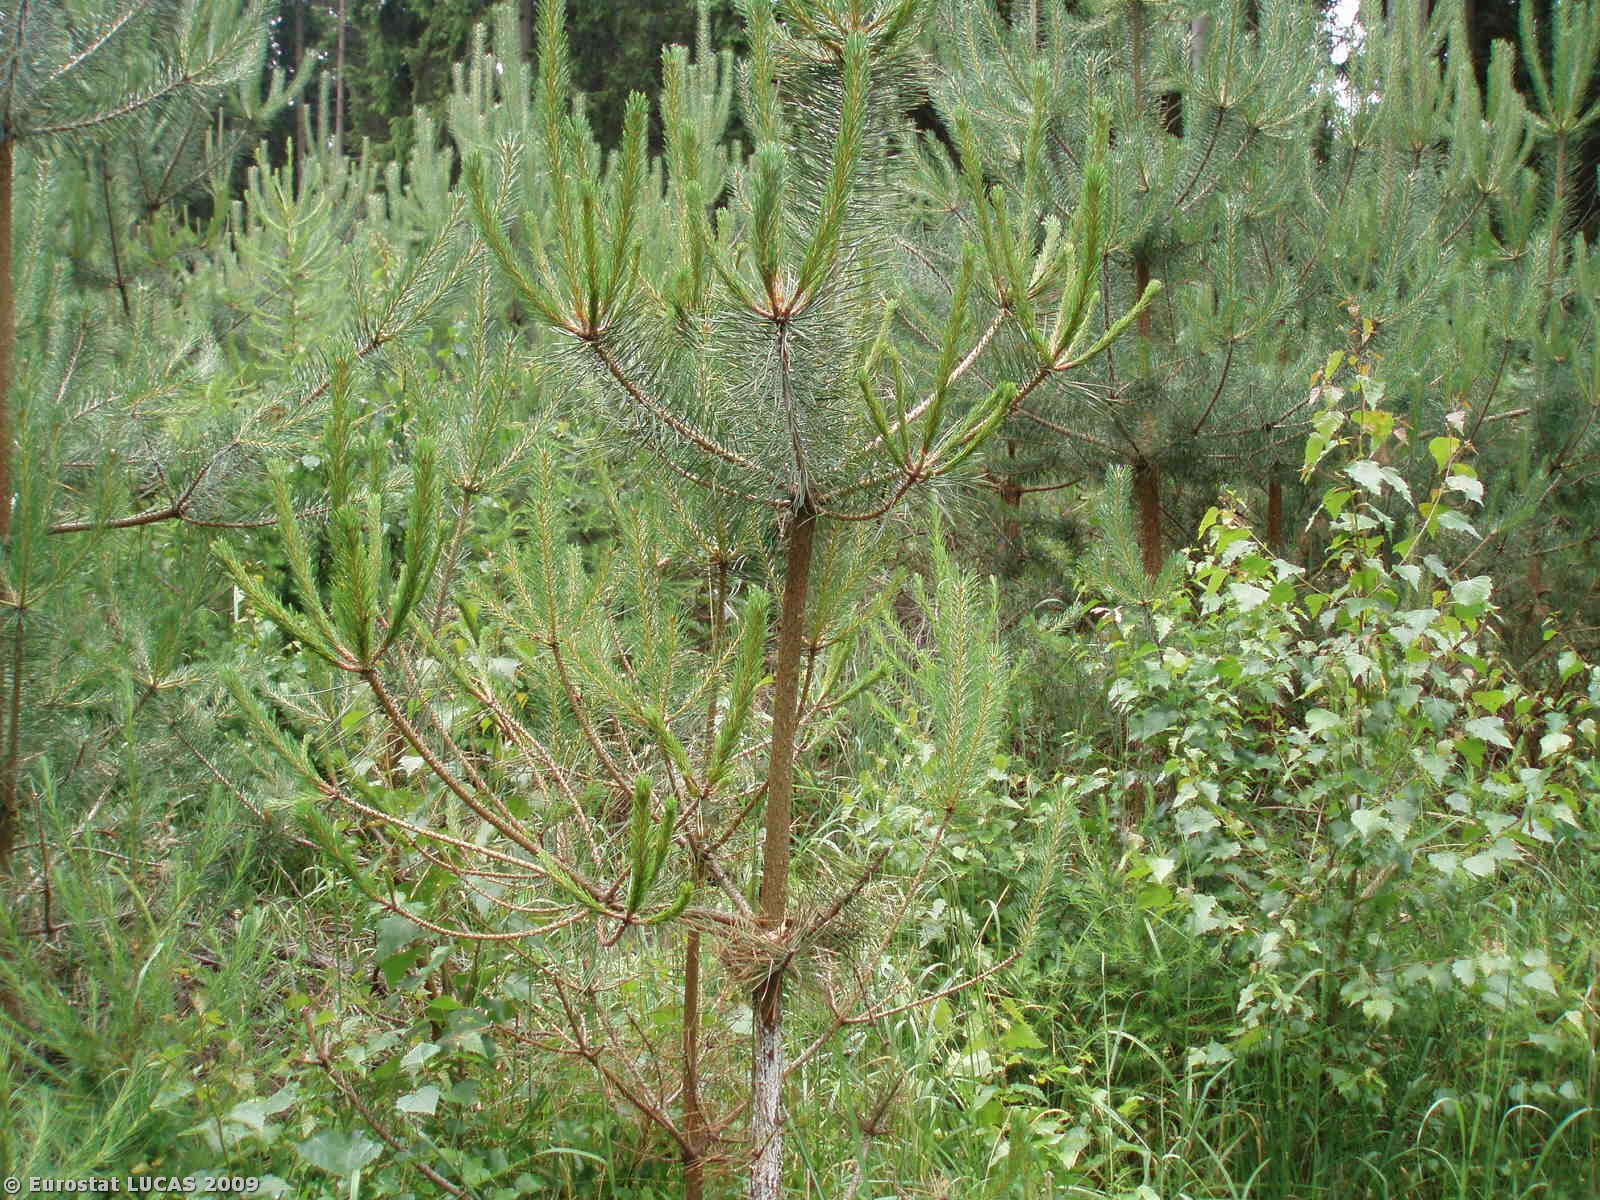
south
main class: Woodland
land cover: Mixed woodland
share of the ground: > 75 %
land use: Forestry
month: June
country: CZ
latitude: 49.8722
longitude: 14.2171
